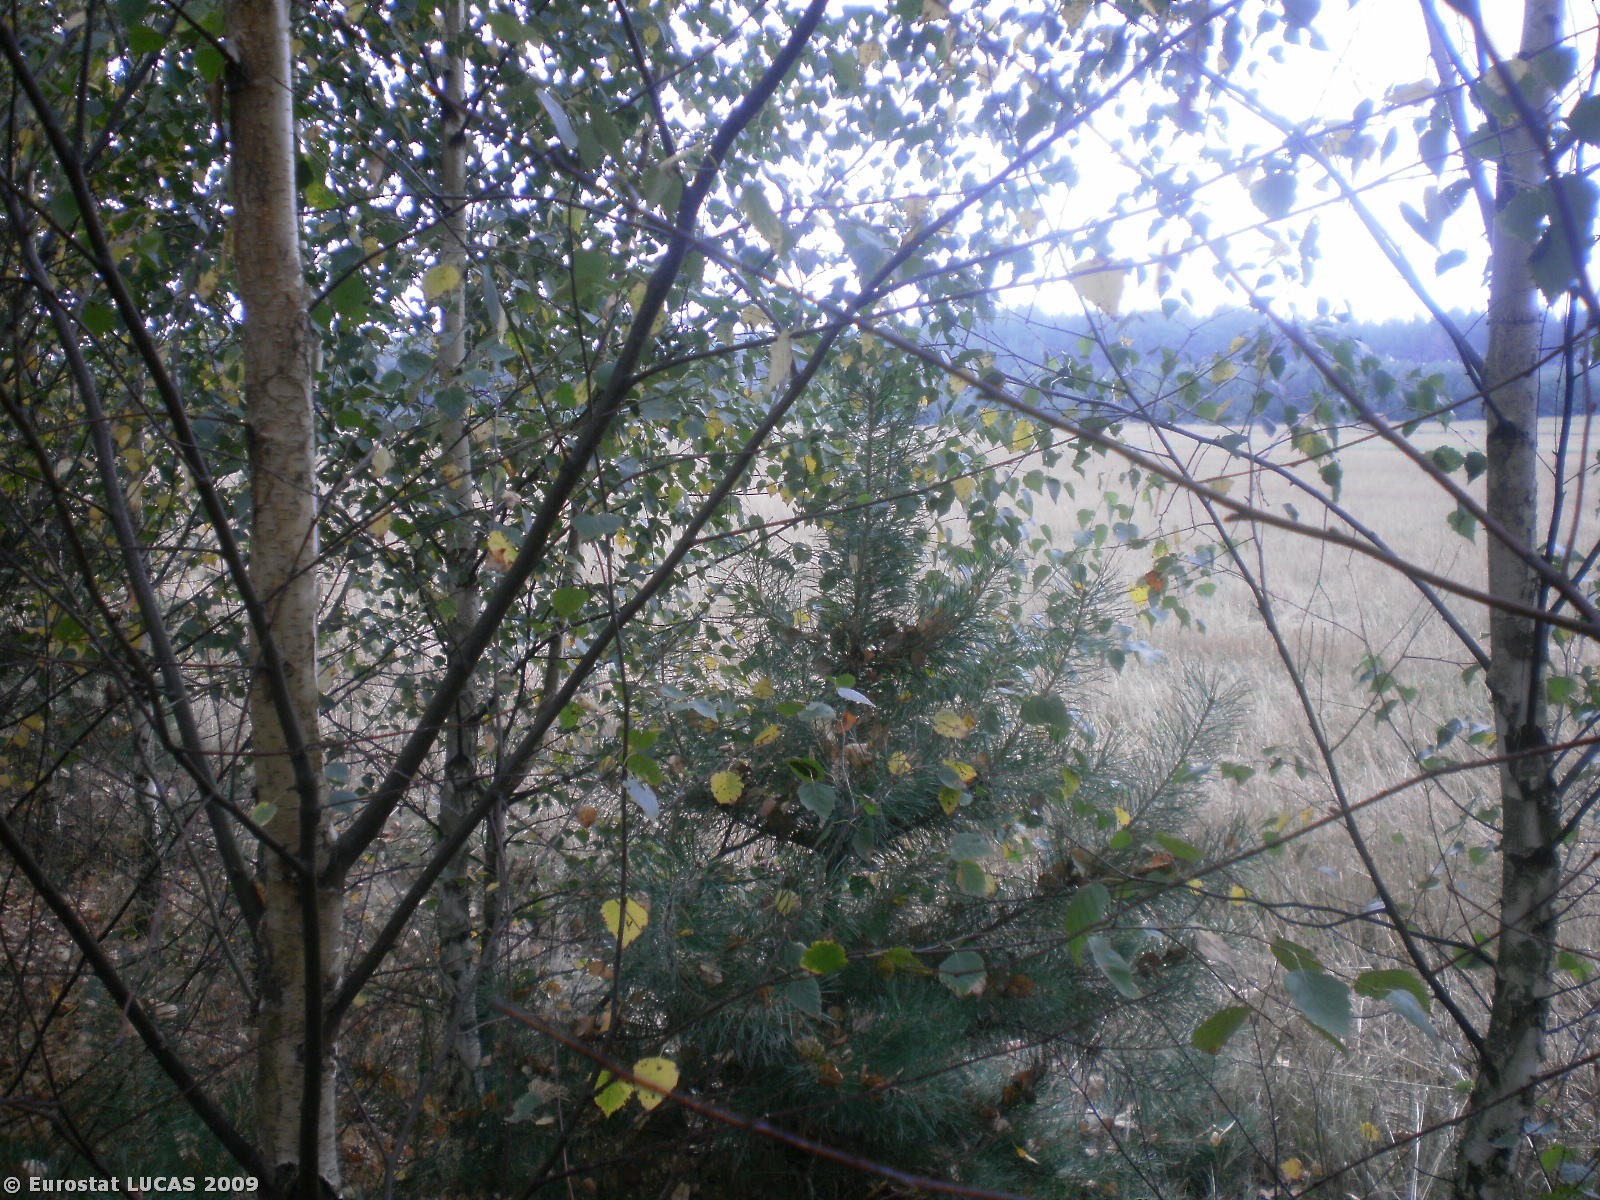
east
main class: Woodland
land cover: Mixed woodland
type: hemiboreal forest and nemoral coniferous forest and mixed broadleaved-coniferous forest
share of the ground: > 75 %
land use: Forestry
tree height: > 5 m
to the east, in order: Mixed woodland; Rye; Other non-permanent industrial crops; Tracks; Grassland with sparse tree/shrub cover; Coniferous woodland
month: August
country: PL
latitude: 53.1937
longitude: 20.9546
